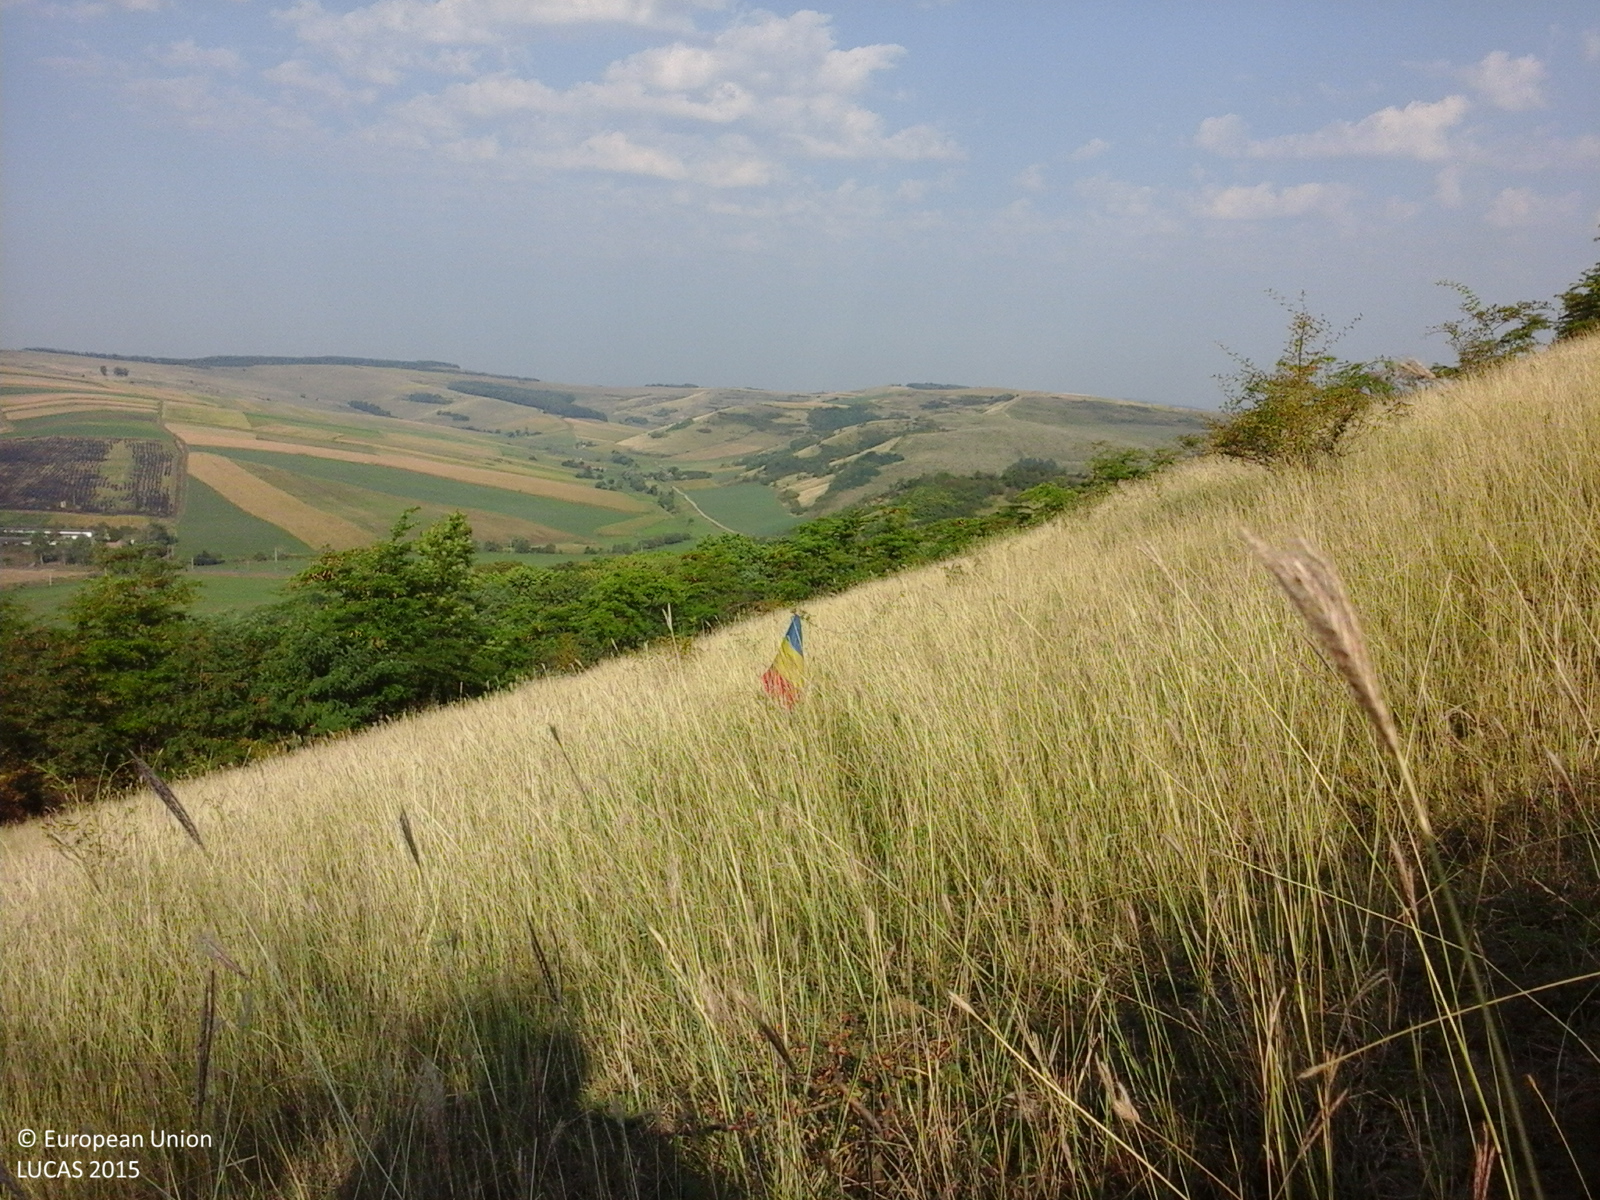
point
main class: Grassland
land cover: Grassland with sparse tree/shrub cover
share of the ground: > 75 %
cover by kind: herbaceous plants 95 %, broadleaved forest trees 5 %
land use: Agriculture (excluding fallow land and kitchen gardens)
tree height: < 5 m
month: September
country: RO
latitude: 46.7743
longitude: 24.2938
